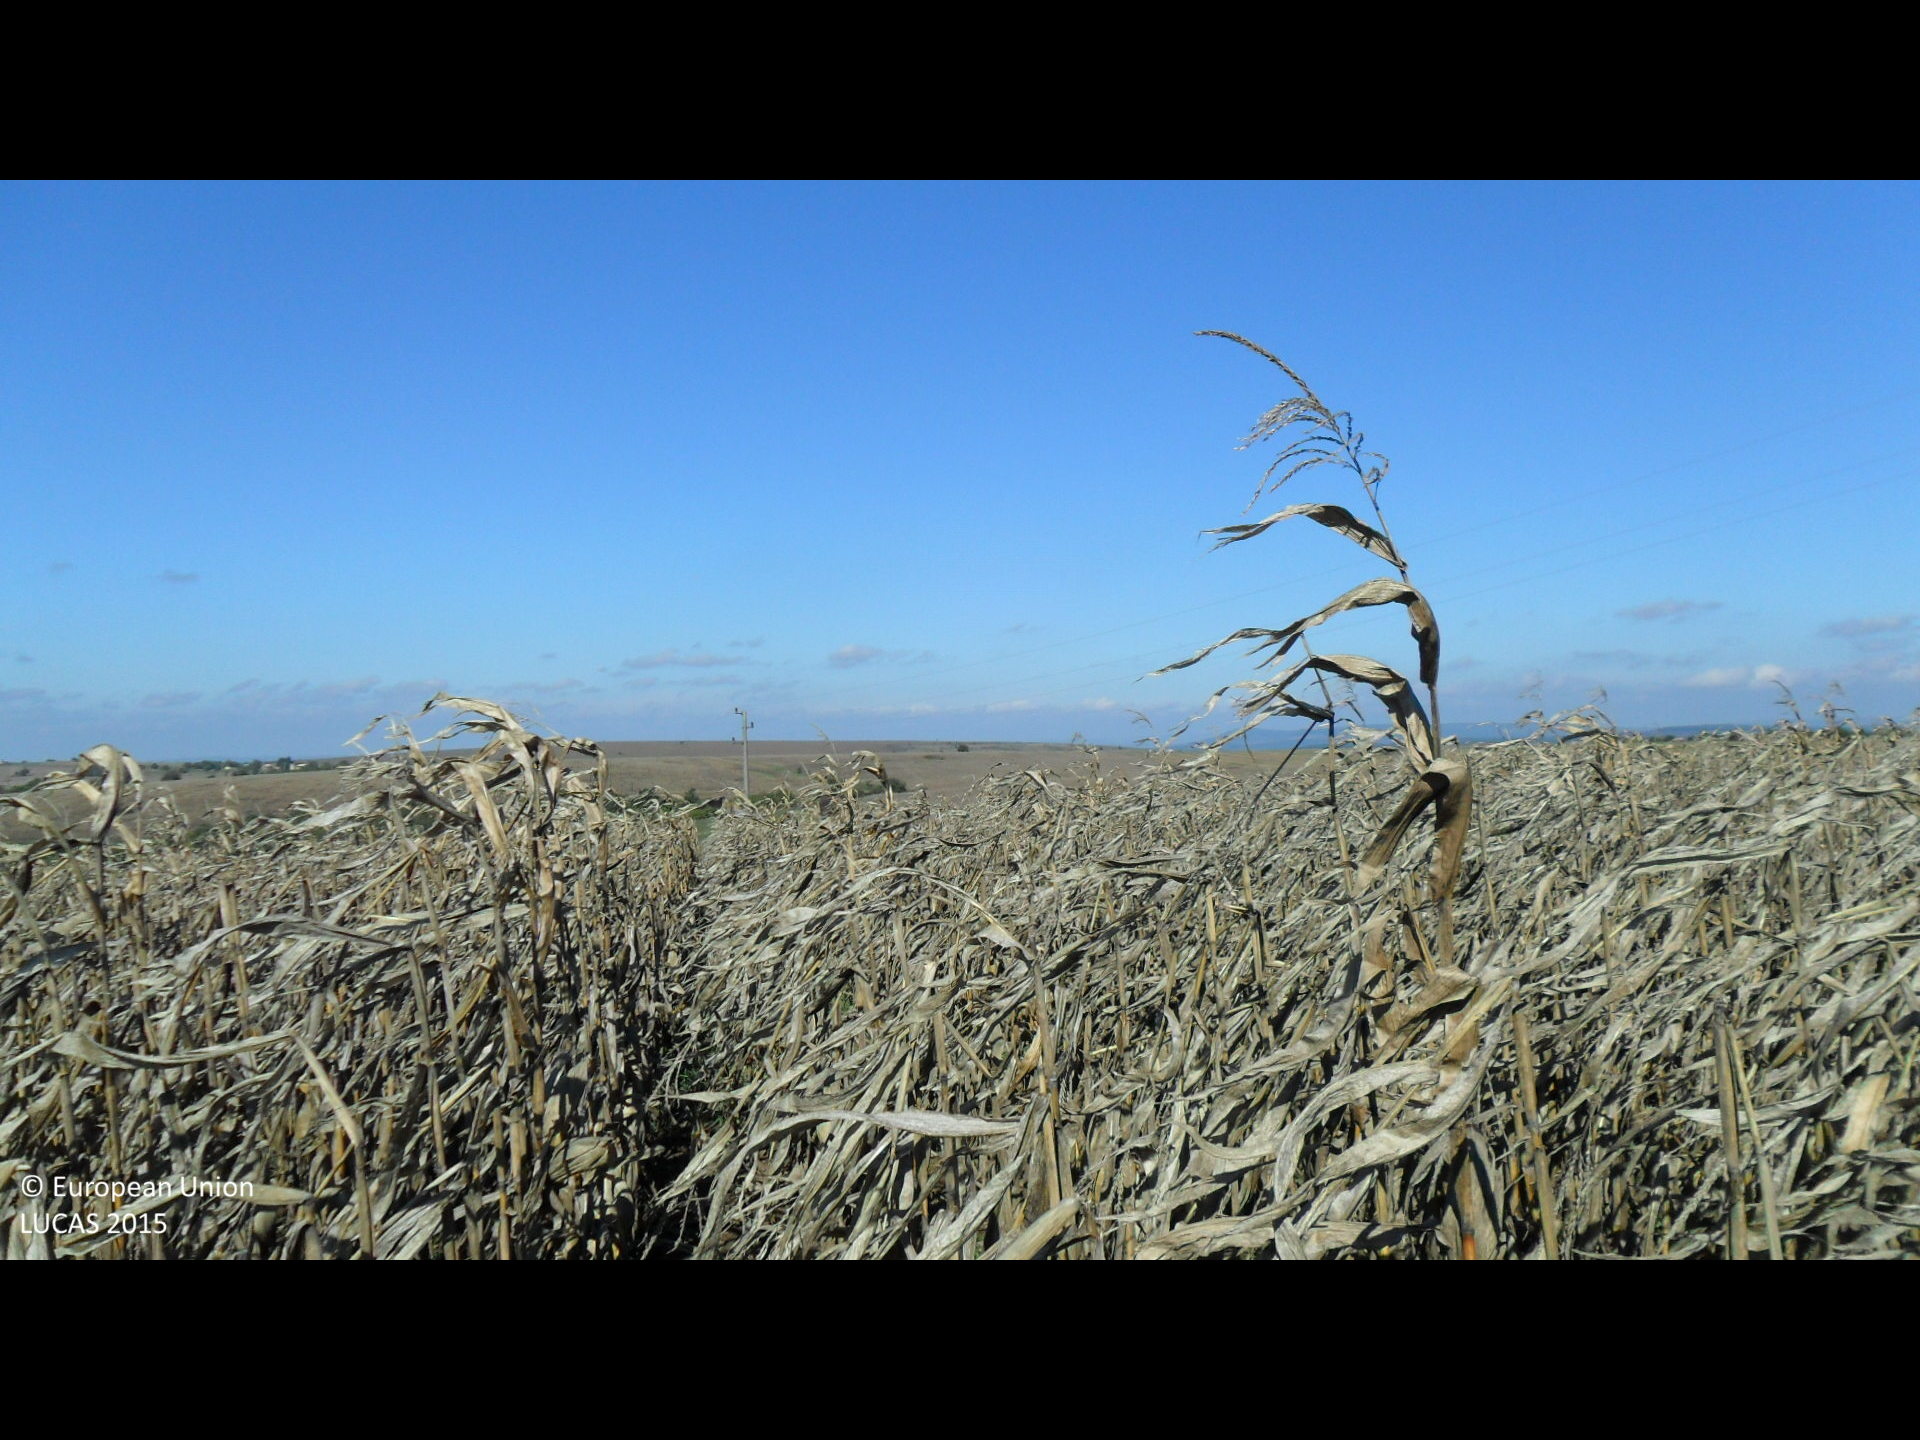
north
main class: Cropland
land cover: Maize
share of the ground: > 75 %
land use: Agriculture (excluding fallow land and kitchen gardens)
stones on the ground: < 10 %
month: October
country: BG
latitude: 43.2015
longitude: 26.2795
